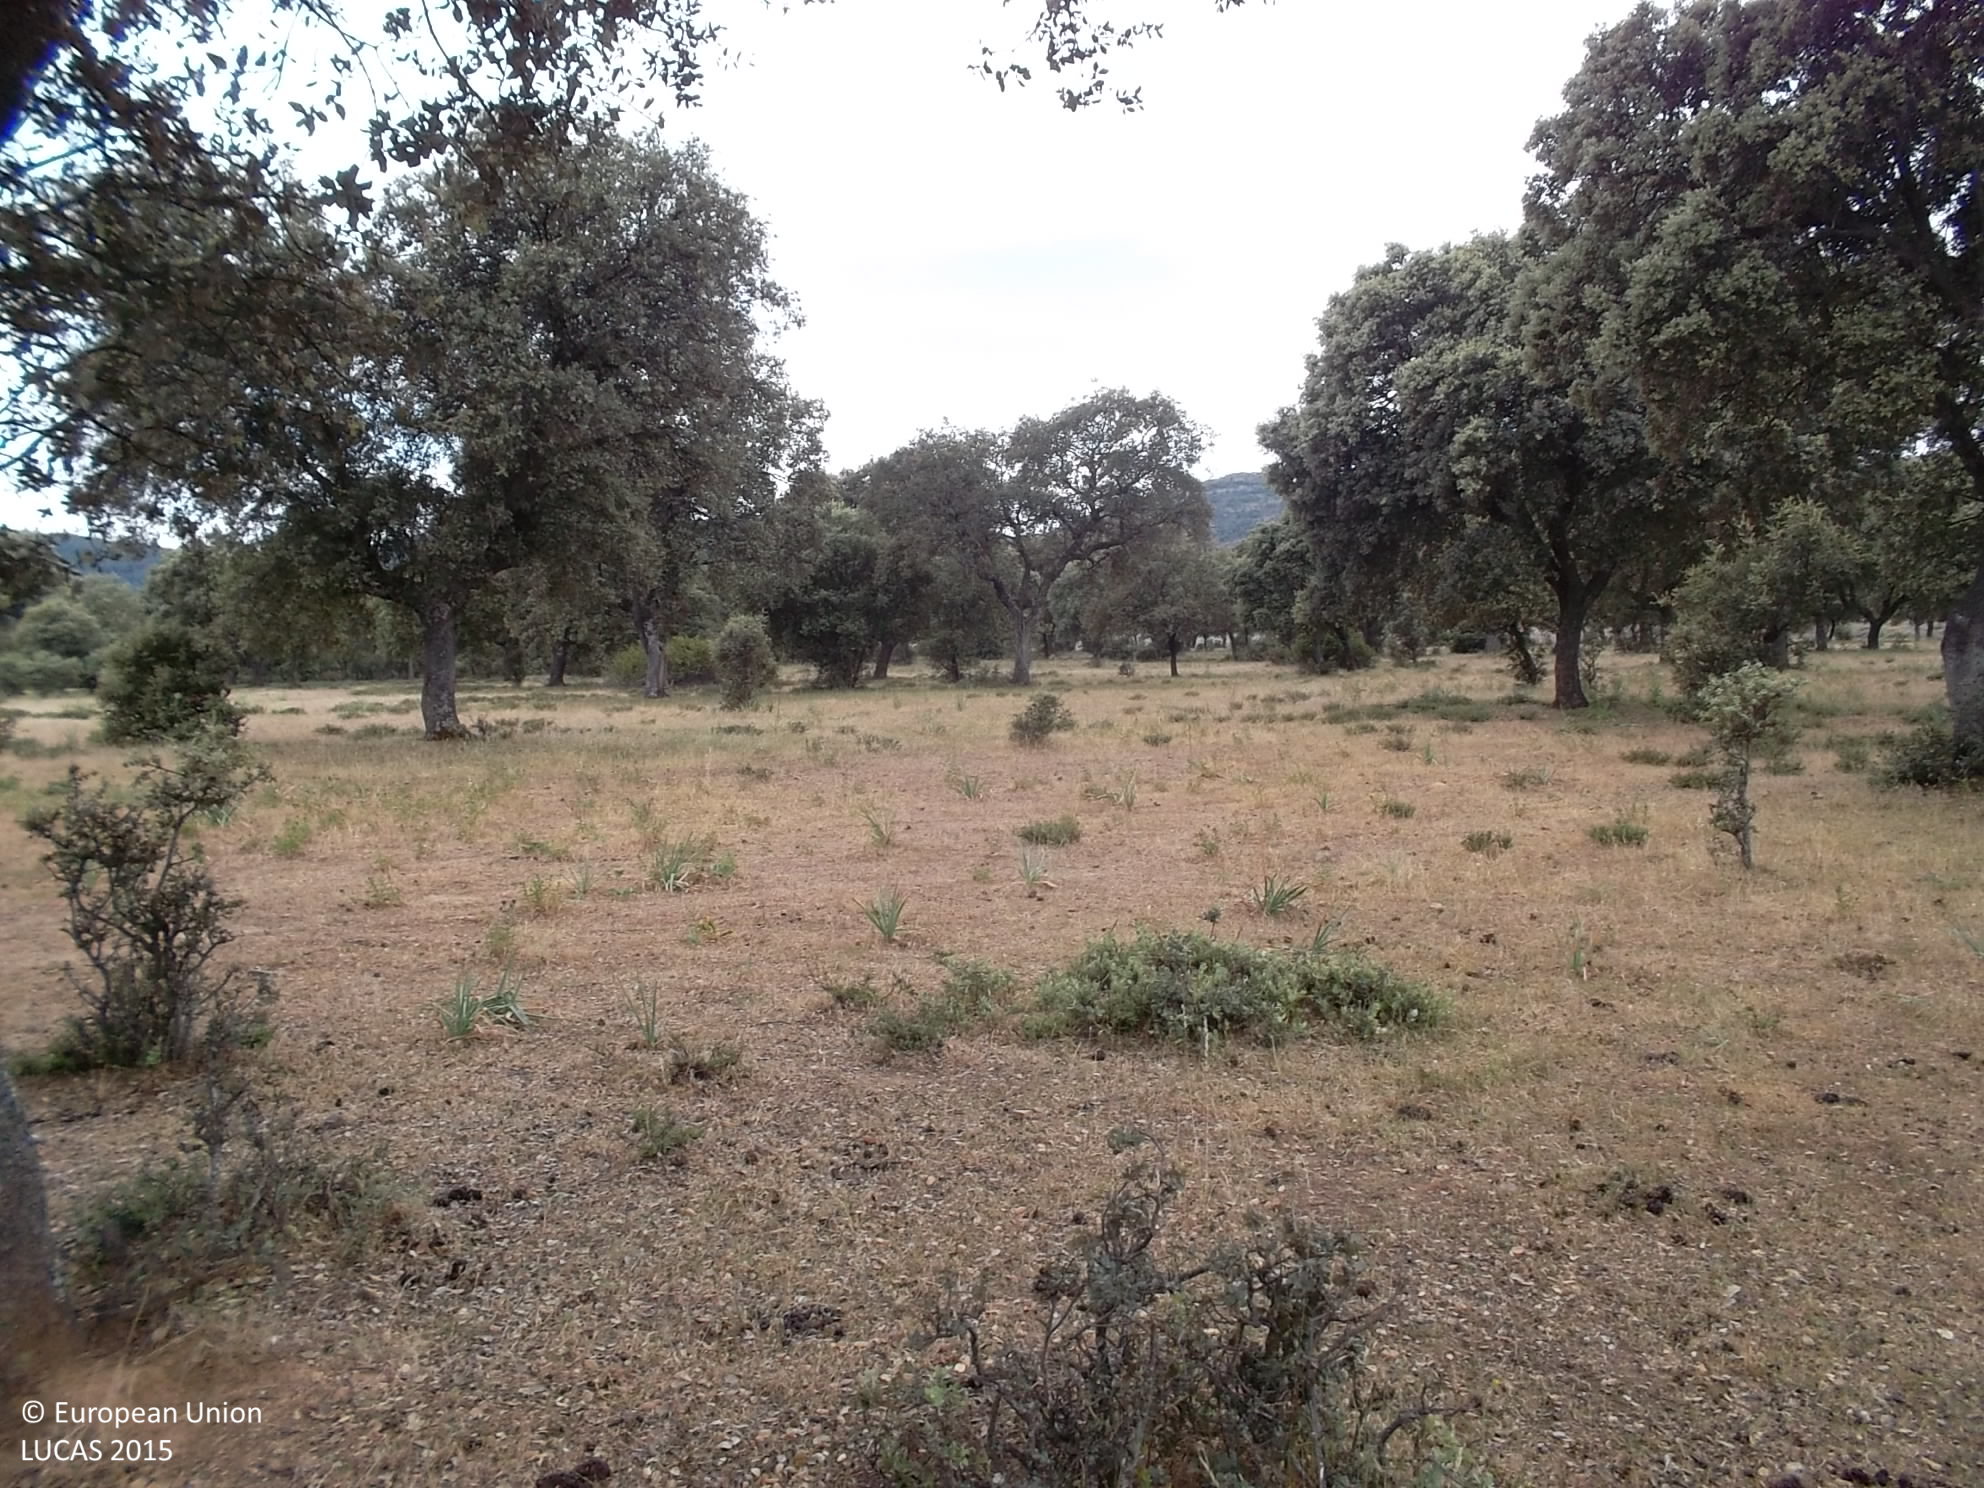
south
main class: Woodland
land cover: Broadleaved woodland
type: broadleaved evergreen forest
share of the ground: 25 - 50 %
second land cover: Spontaneously vegetated surfaces
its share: > 75 %
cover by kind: herbaceous plants 50 %, broadleaved forest trees 40 %, shrubs 10 %
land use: Forestry
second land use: Agriculture (excluding fallow land and kitchen gardens)
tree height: > 5 m
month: May
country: ES
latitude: 38.5710
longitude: -4.4251
